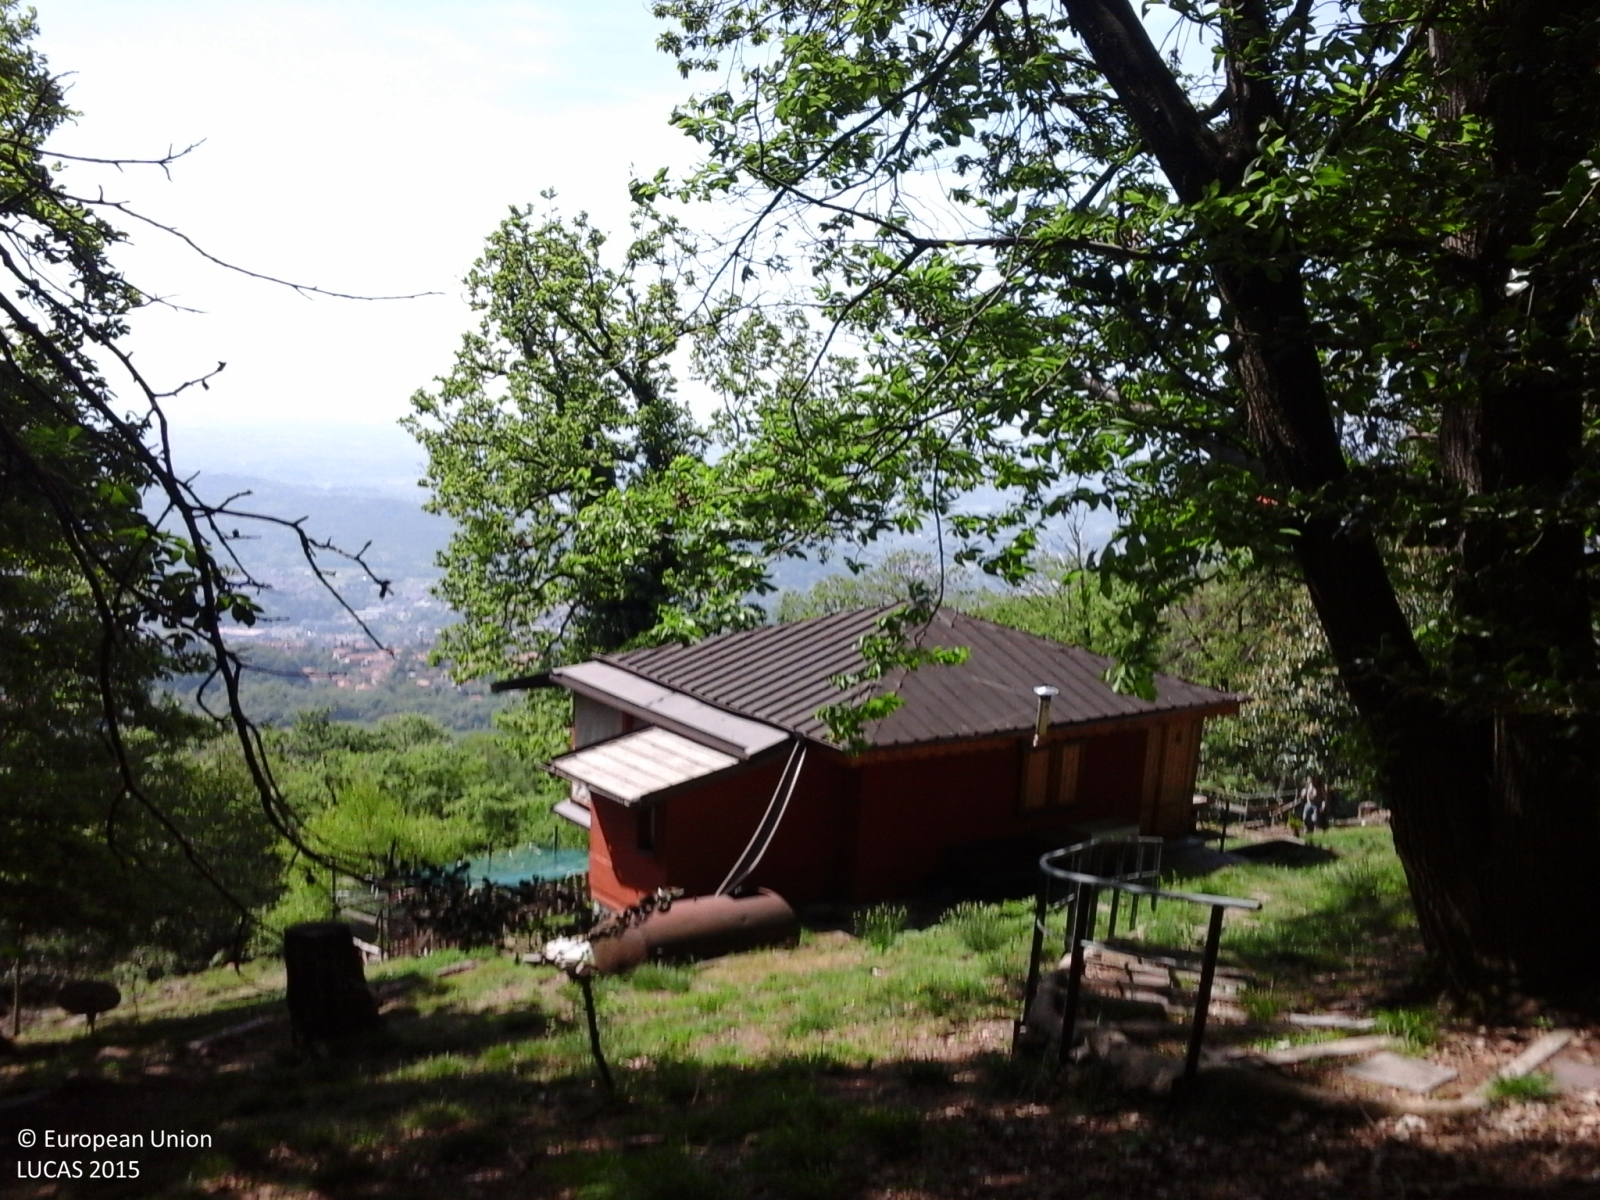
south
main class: Woodland
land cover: Other mixed woodland
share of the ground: > 75 %
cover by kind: coniferous forest trees 50 %, broadleaved forest trees 30 %, shrubs 10 %, unconsolidated bare surface 10 %
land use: Forestry
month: May
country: IT
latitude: 45.8250
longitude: 9.1132
